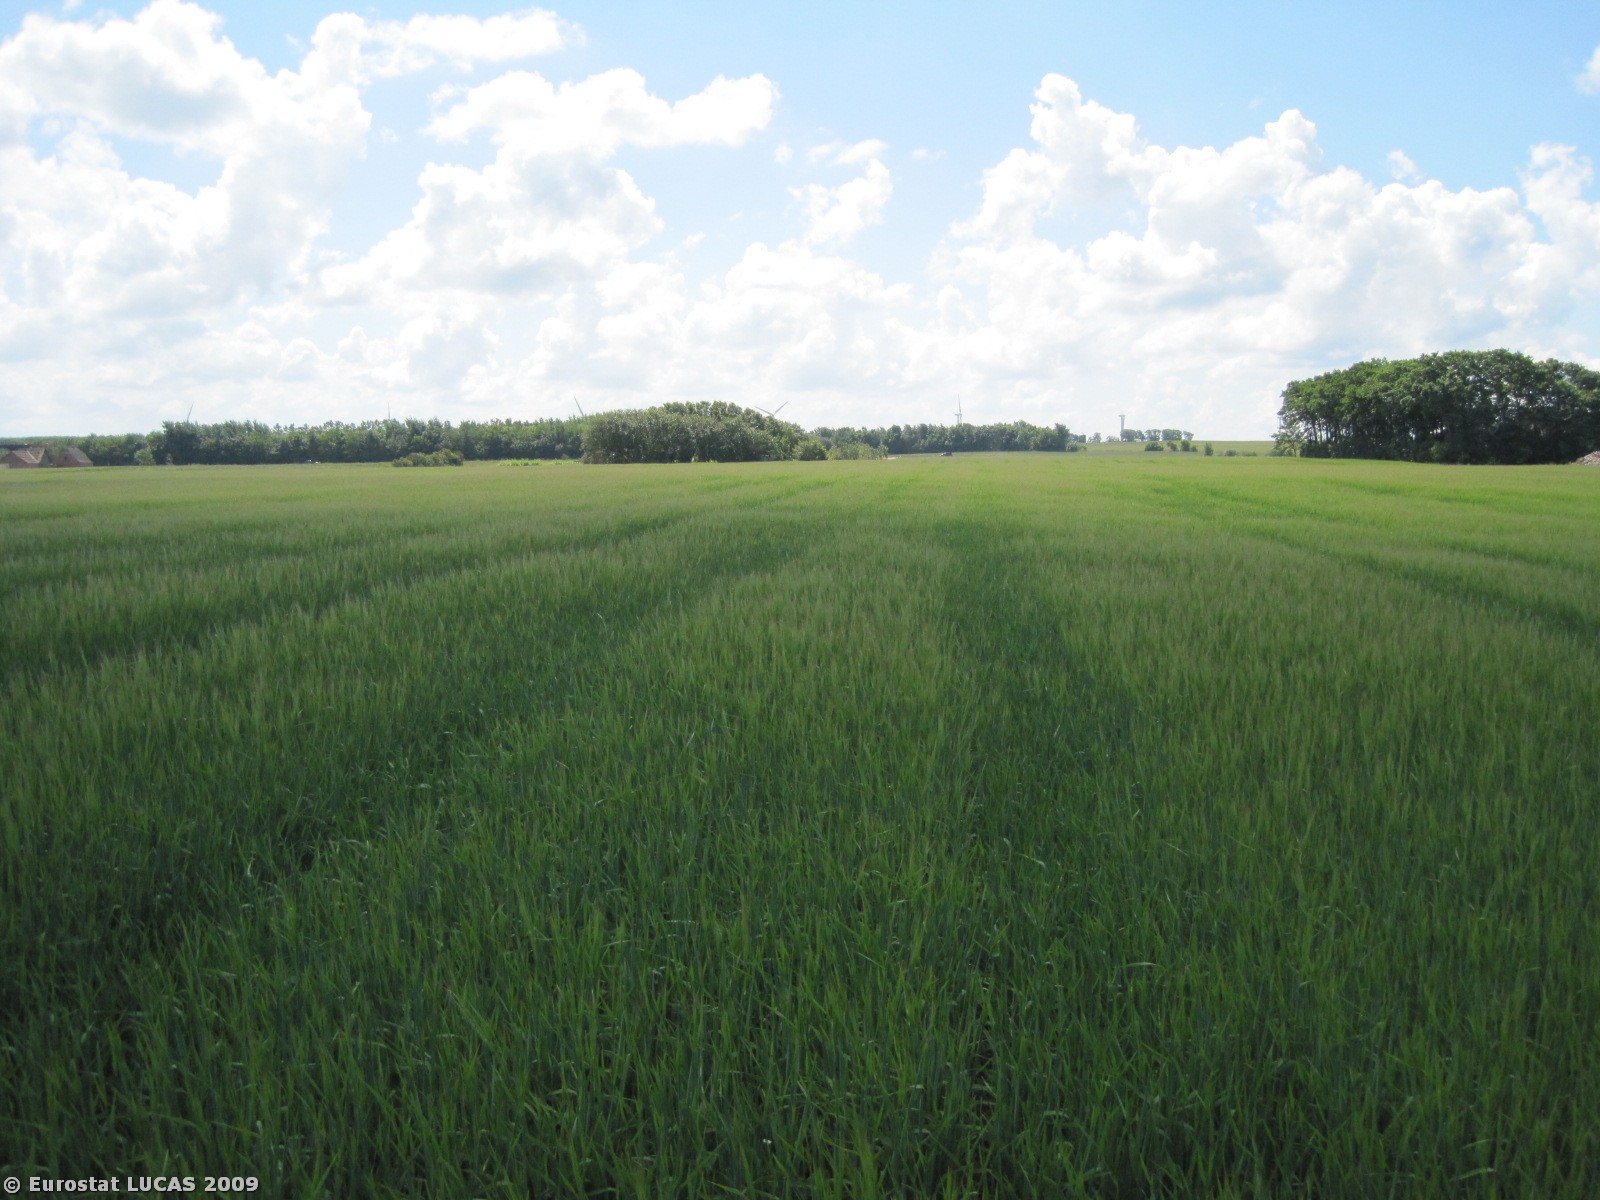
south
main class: Cropland
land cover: Barley
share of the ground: > 75 %
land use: Agriculture (excluding fallow land and kitchen gardens)
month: June
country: DK
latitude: 56.6511
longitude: 8.9738
